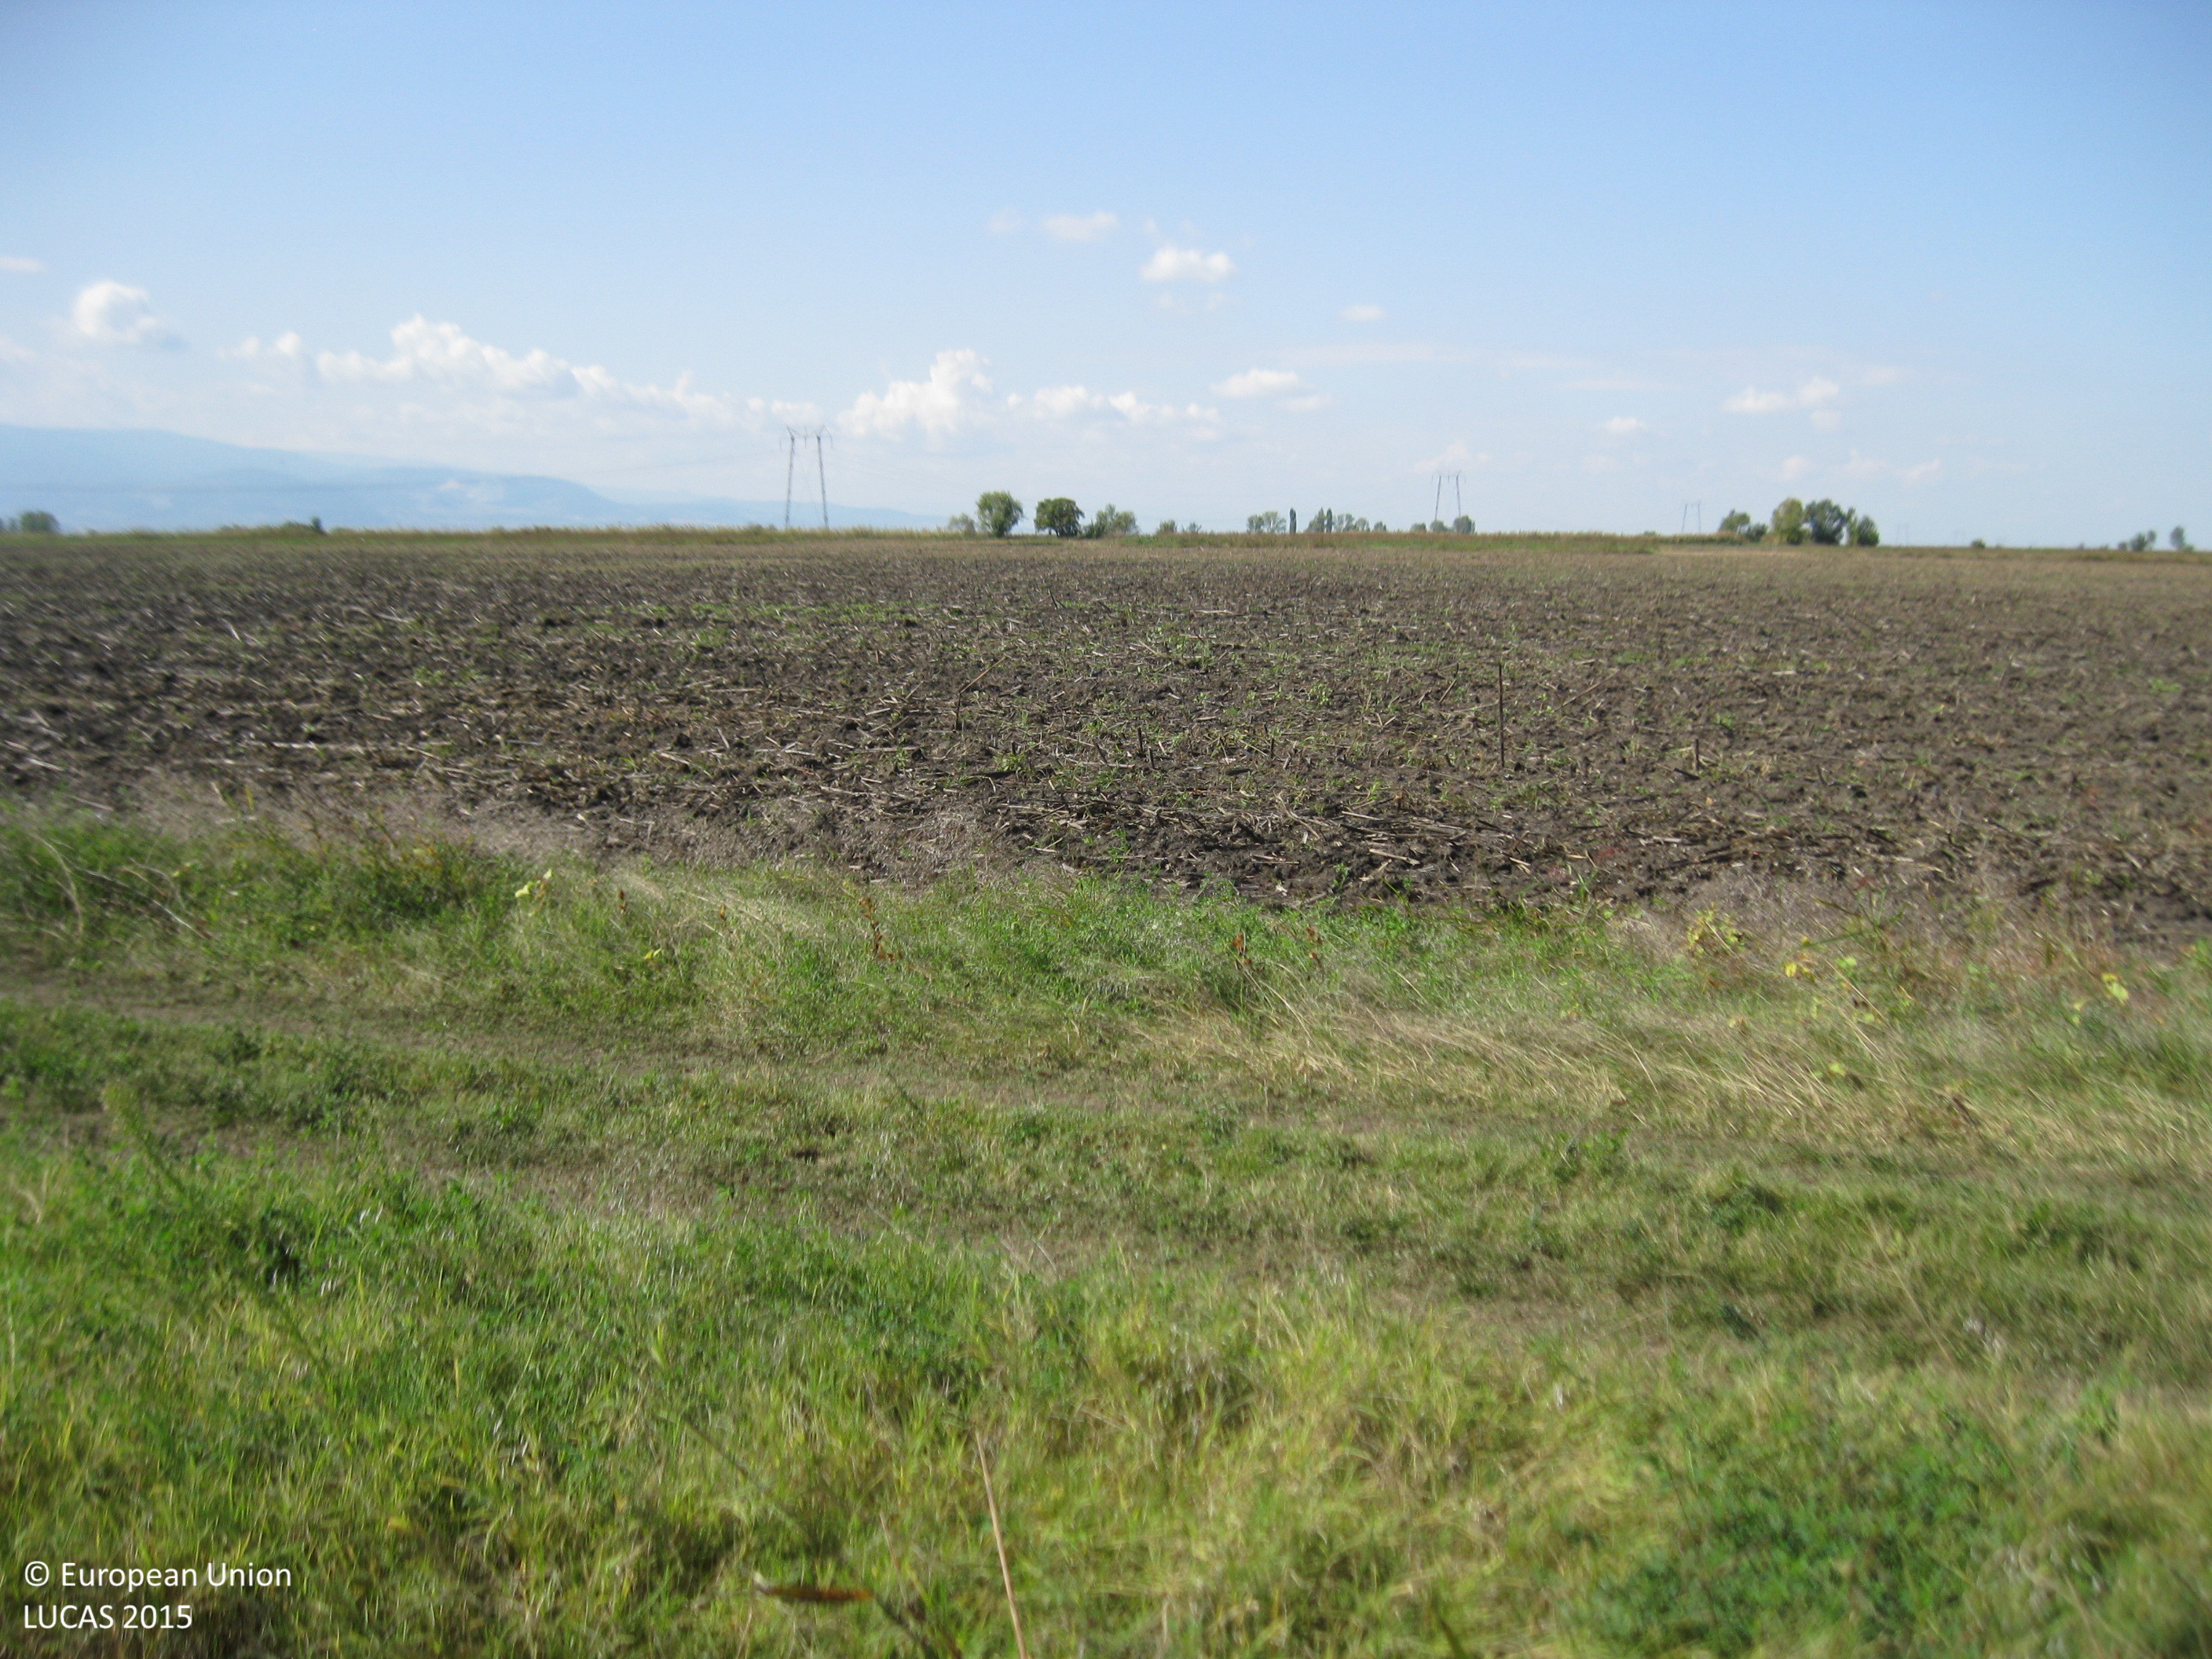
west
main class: Cropland
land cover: Sunflower
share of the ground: 10 - 25 %
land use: Agriculture (excluding fallow land and kitchen gardens)
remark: Harvested field
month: October
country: BG
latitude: 42.1035
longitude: 24.9648
